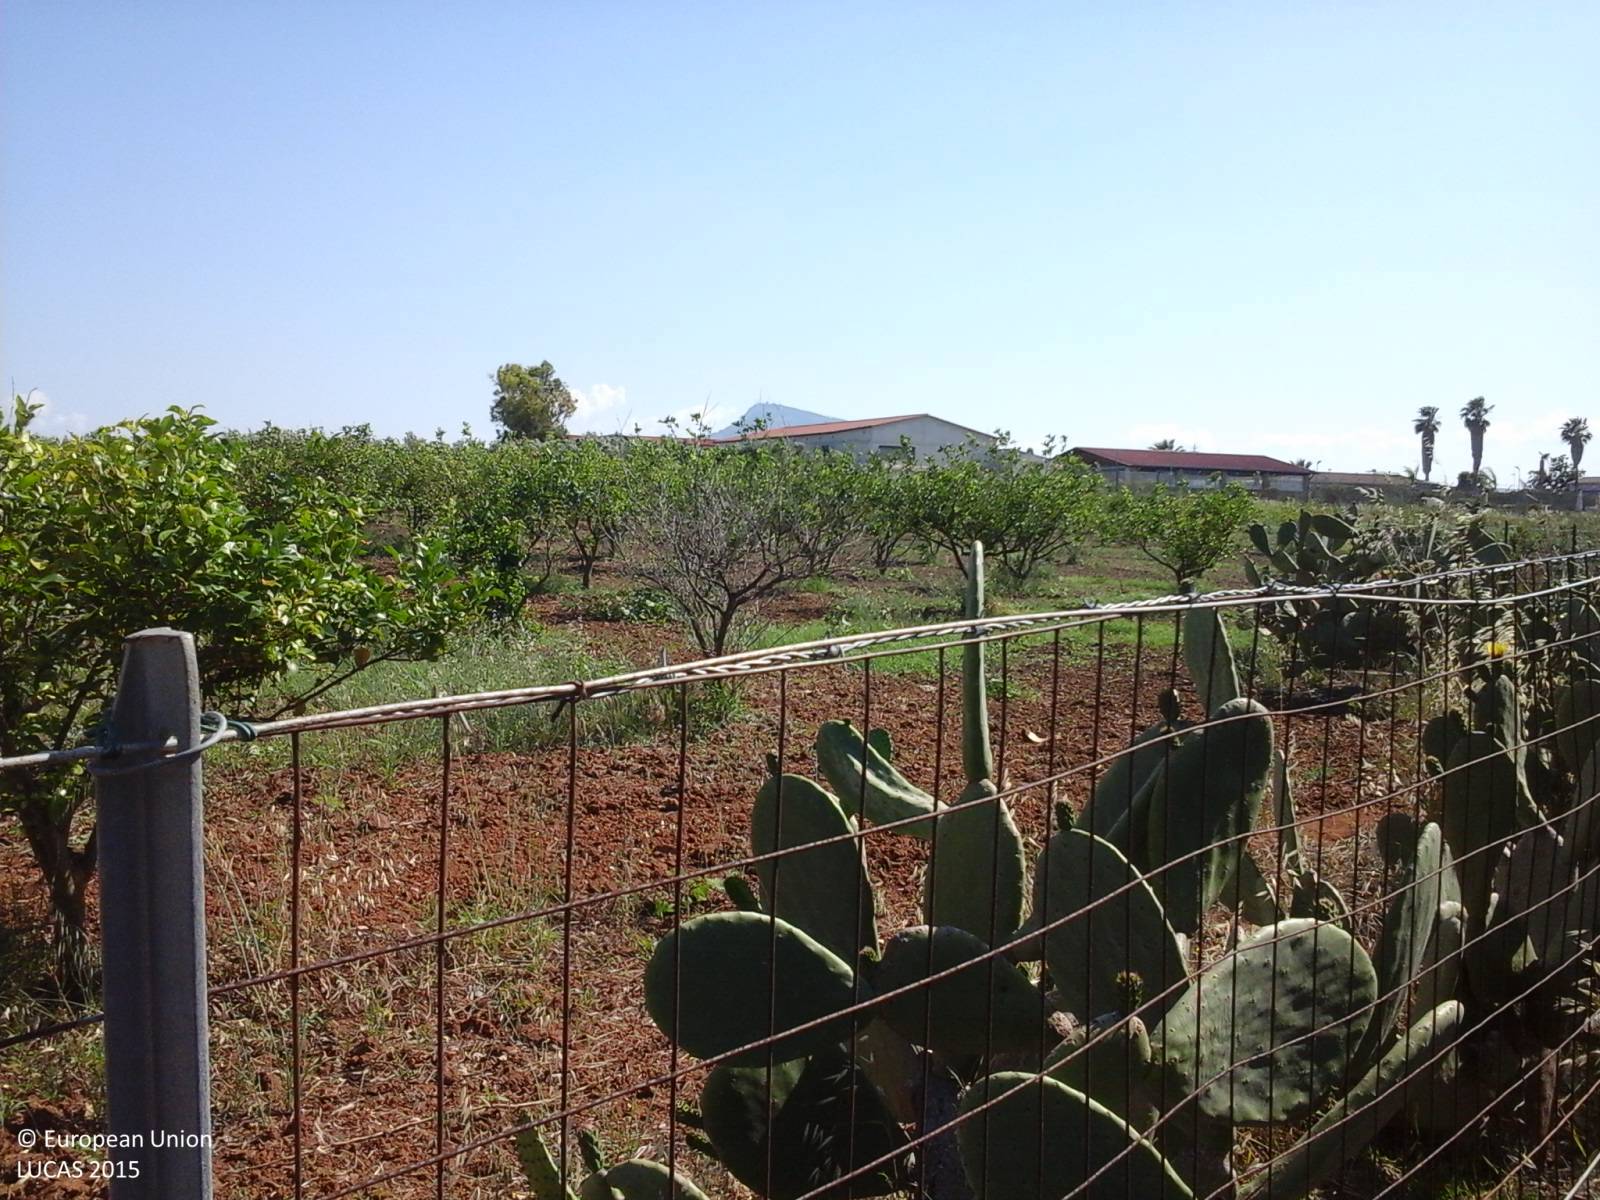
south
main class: Cropland
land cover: Other citrus fruit
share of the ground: 25 - 50 %
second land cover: Spontaneously vegetated surfaces
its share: > 75 %
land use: Agriculture (excluding fallow land and kitchen gardens)
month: June
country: IT
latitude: 38.0272
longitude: 12.9975
